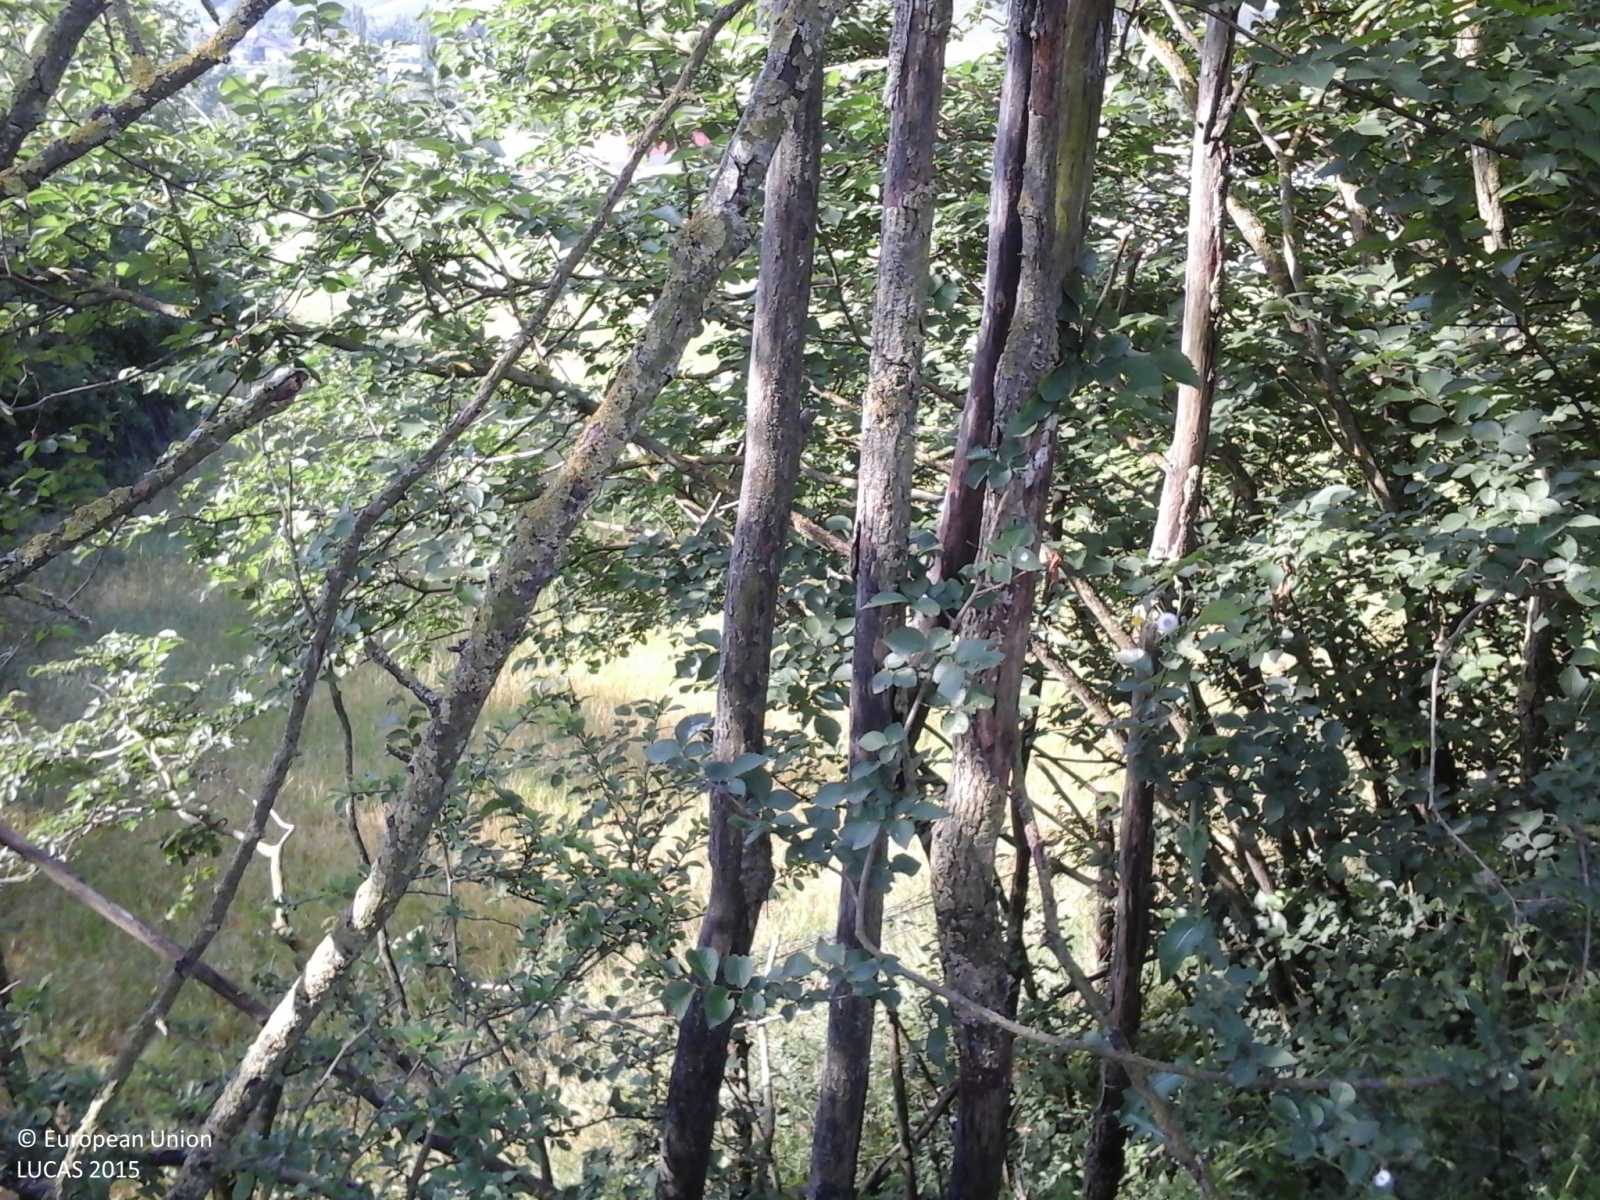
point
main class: Grassland
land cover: Grassland without tree/shrub cover
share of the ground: > 75 %
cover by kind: herbaceous plants 100 %
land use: Agriculture (excluding fallow land and kitchen gardens)
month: May
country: IT
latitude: 44.6751
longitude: 10.1133
